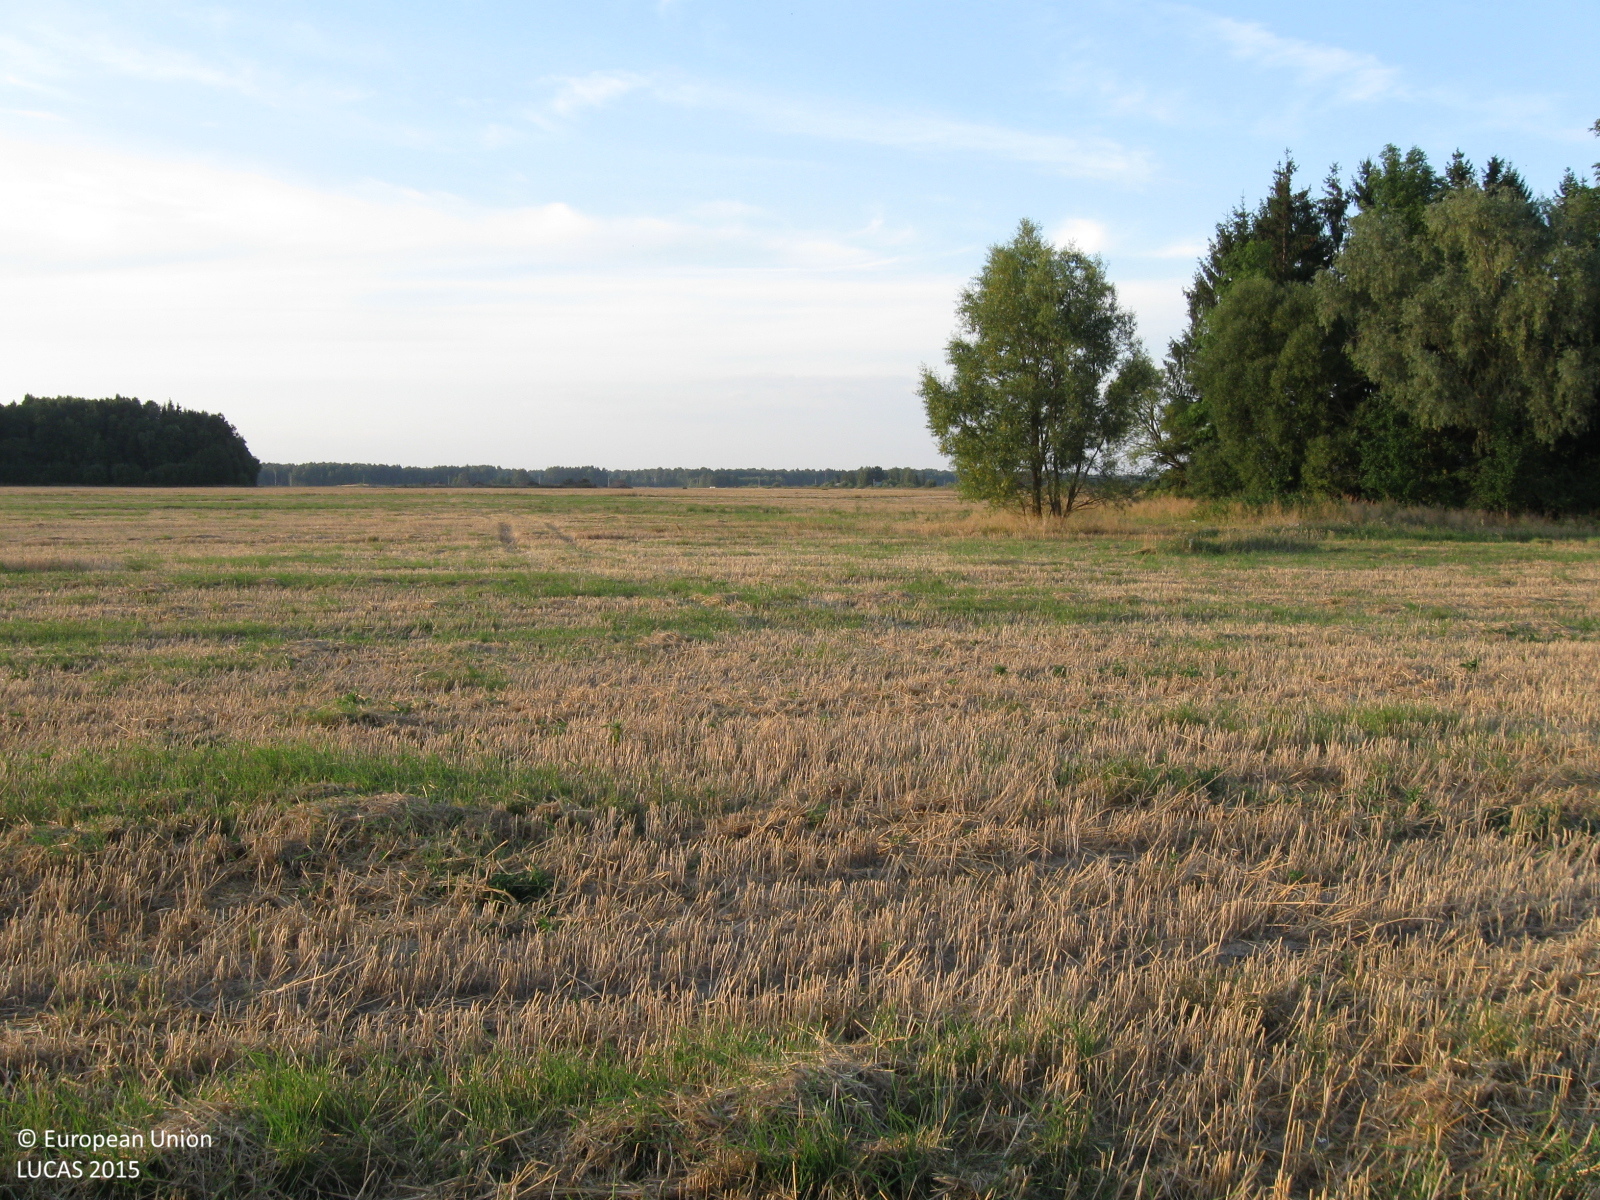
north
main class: Cropland
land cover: Common wheat
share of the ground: > 75 %
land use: Agriculture (excluding fallow land and kitchen gardens)
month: August
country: LT
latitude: 55.2876
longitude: 22.8054
